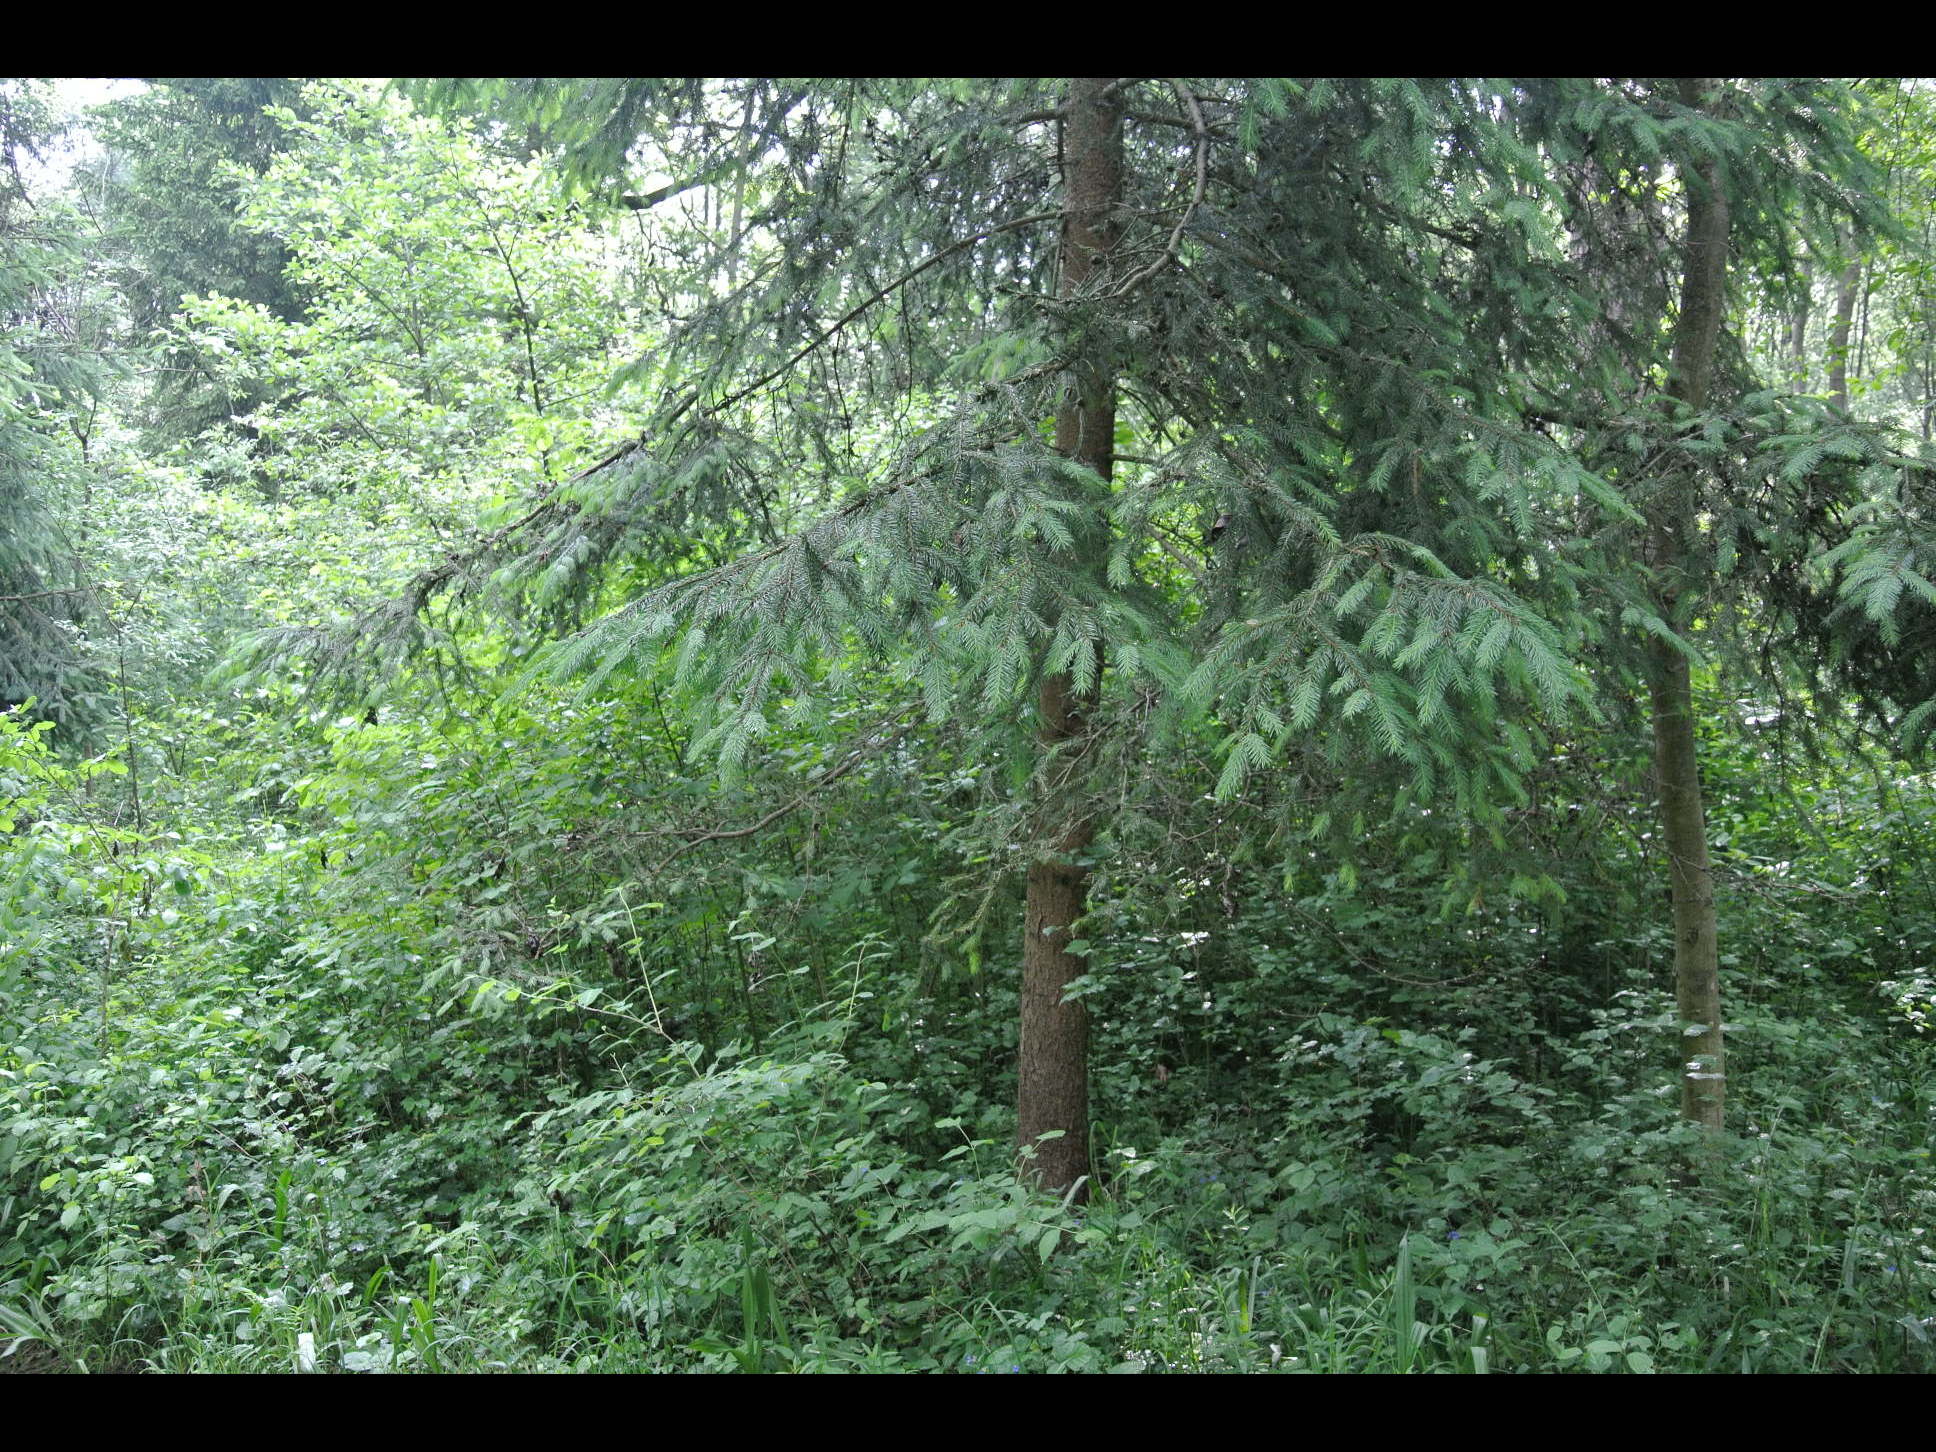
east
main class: Woodland
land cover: Broadleaved woodland
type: beech forest
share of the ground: > 75 %
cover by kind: broadleaved forest trees 90 %, coniferous forest trees 10 %
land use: Forestry
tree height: > 5 m
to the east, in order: Broadleaved woodland; Tracks; Broadleaved woodland
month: May
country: AT
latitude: 48.0443
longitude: 16.5918
